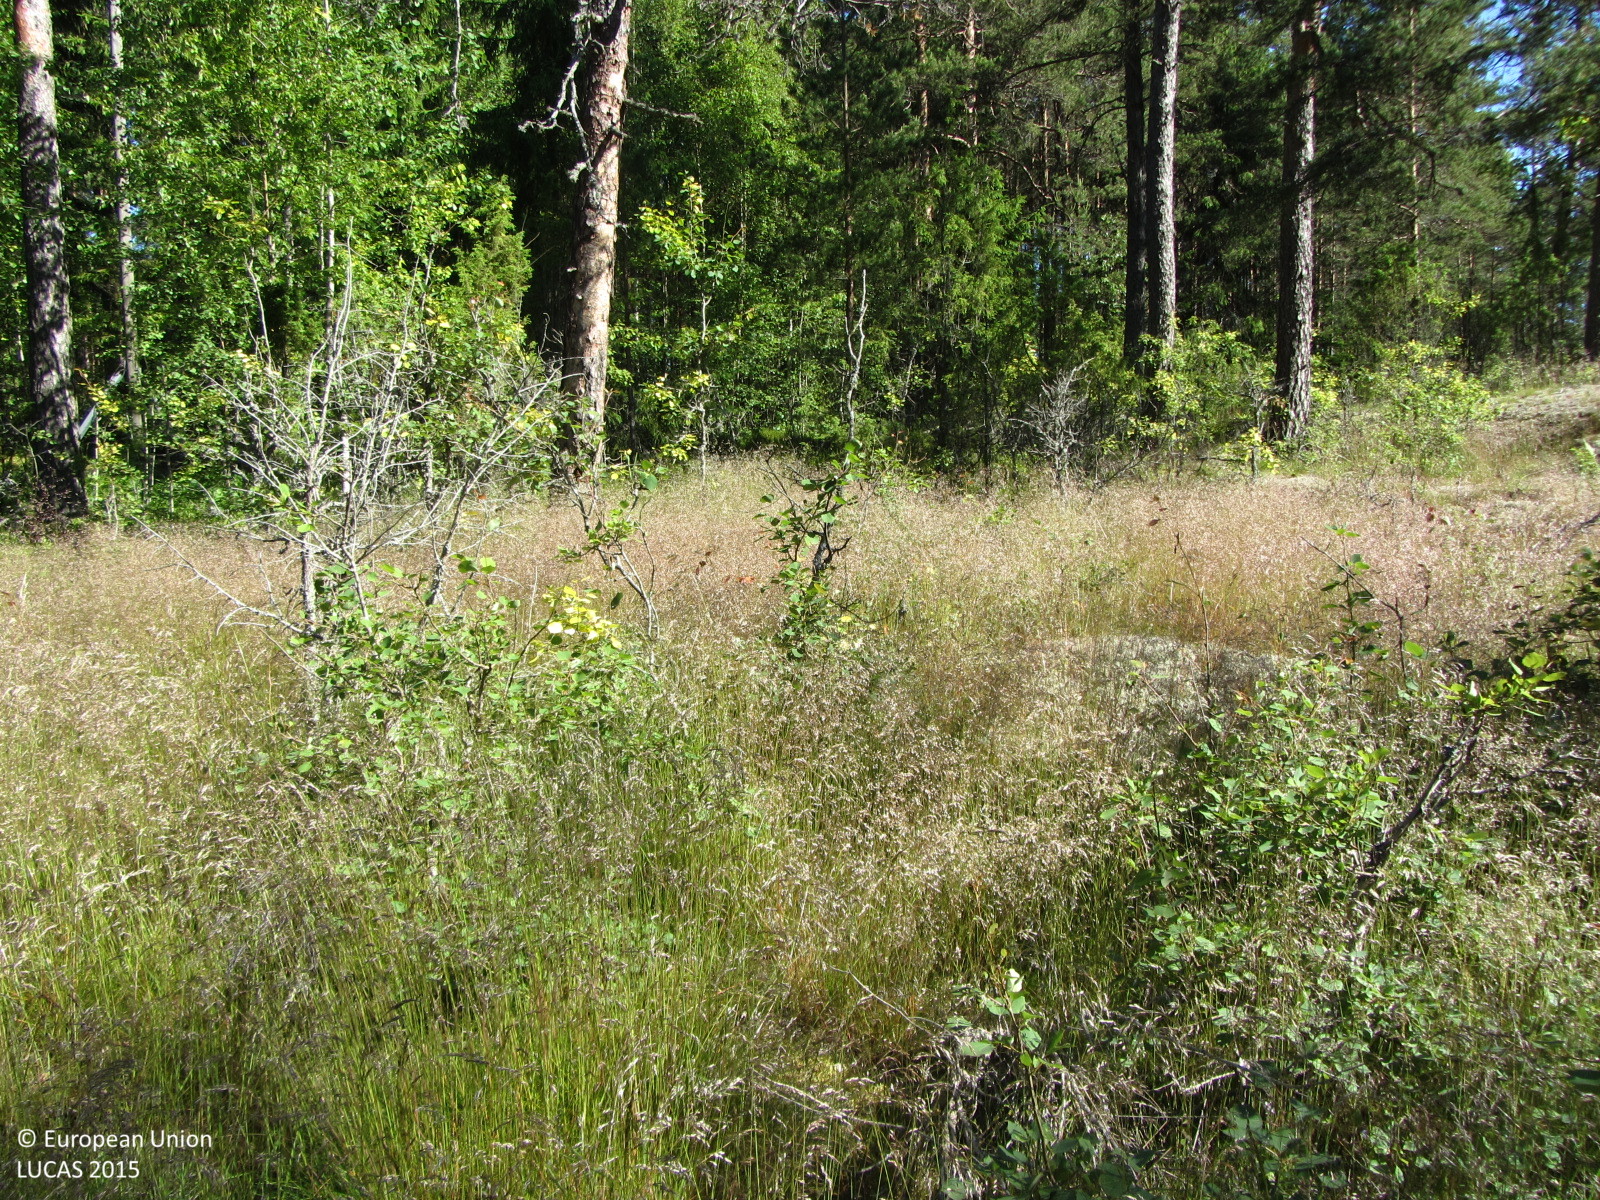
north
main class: Grassland
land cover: Grassland with sparse tree/shrub cover
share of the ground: 50 - 75 %
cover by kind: herbaceous plants 70 %, lichens and mosses 25 %, broadleaved forest trees 5 %
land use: Forestry
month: July
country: FI
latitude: 60.0914
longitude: 23.1546
